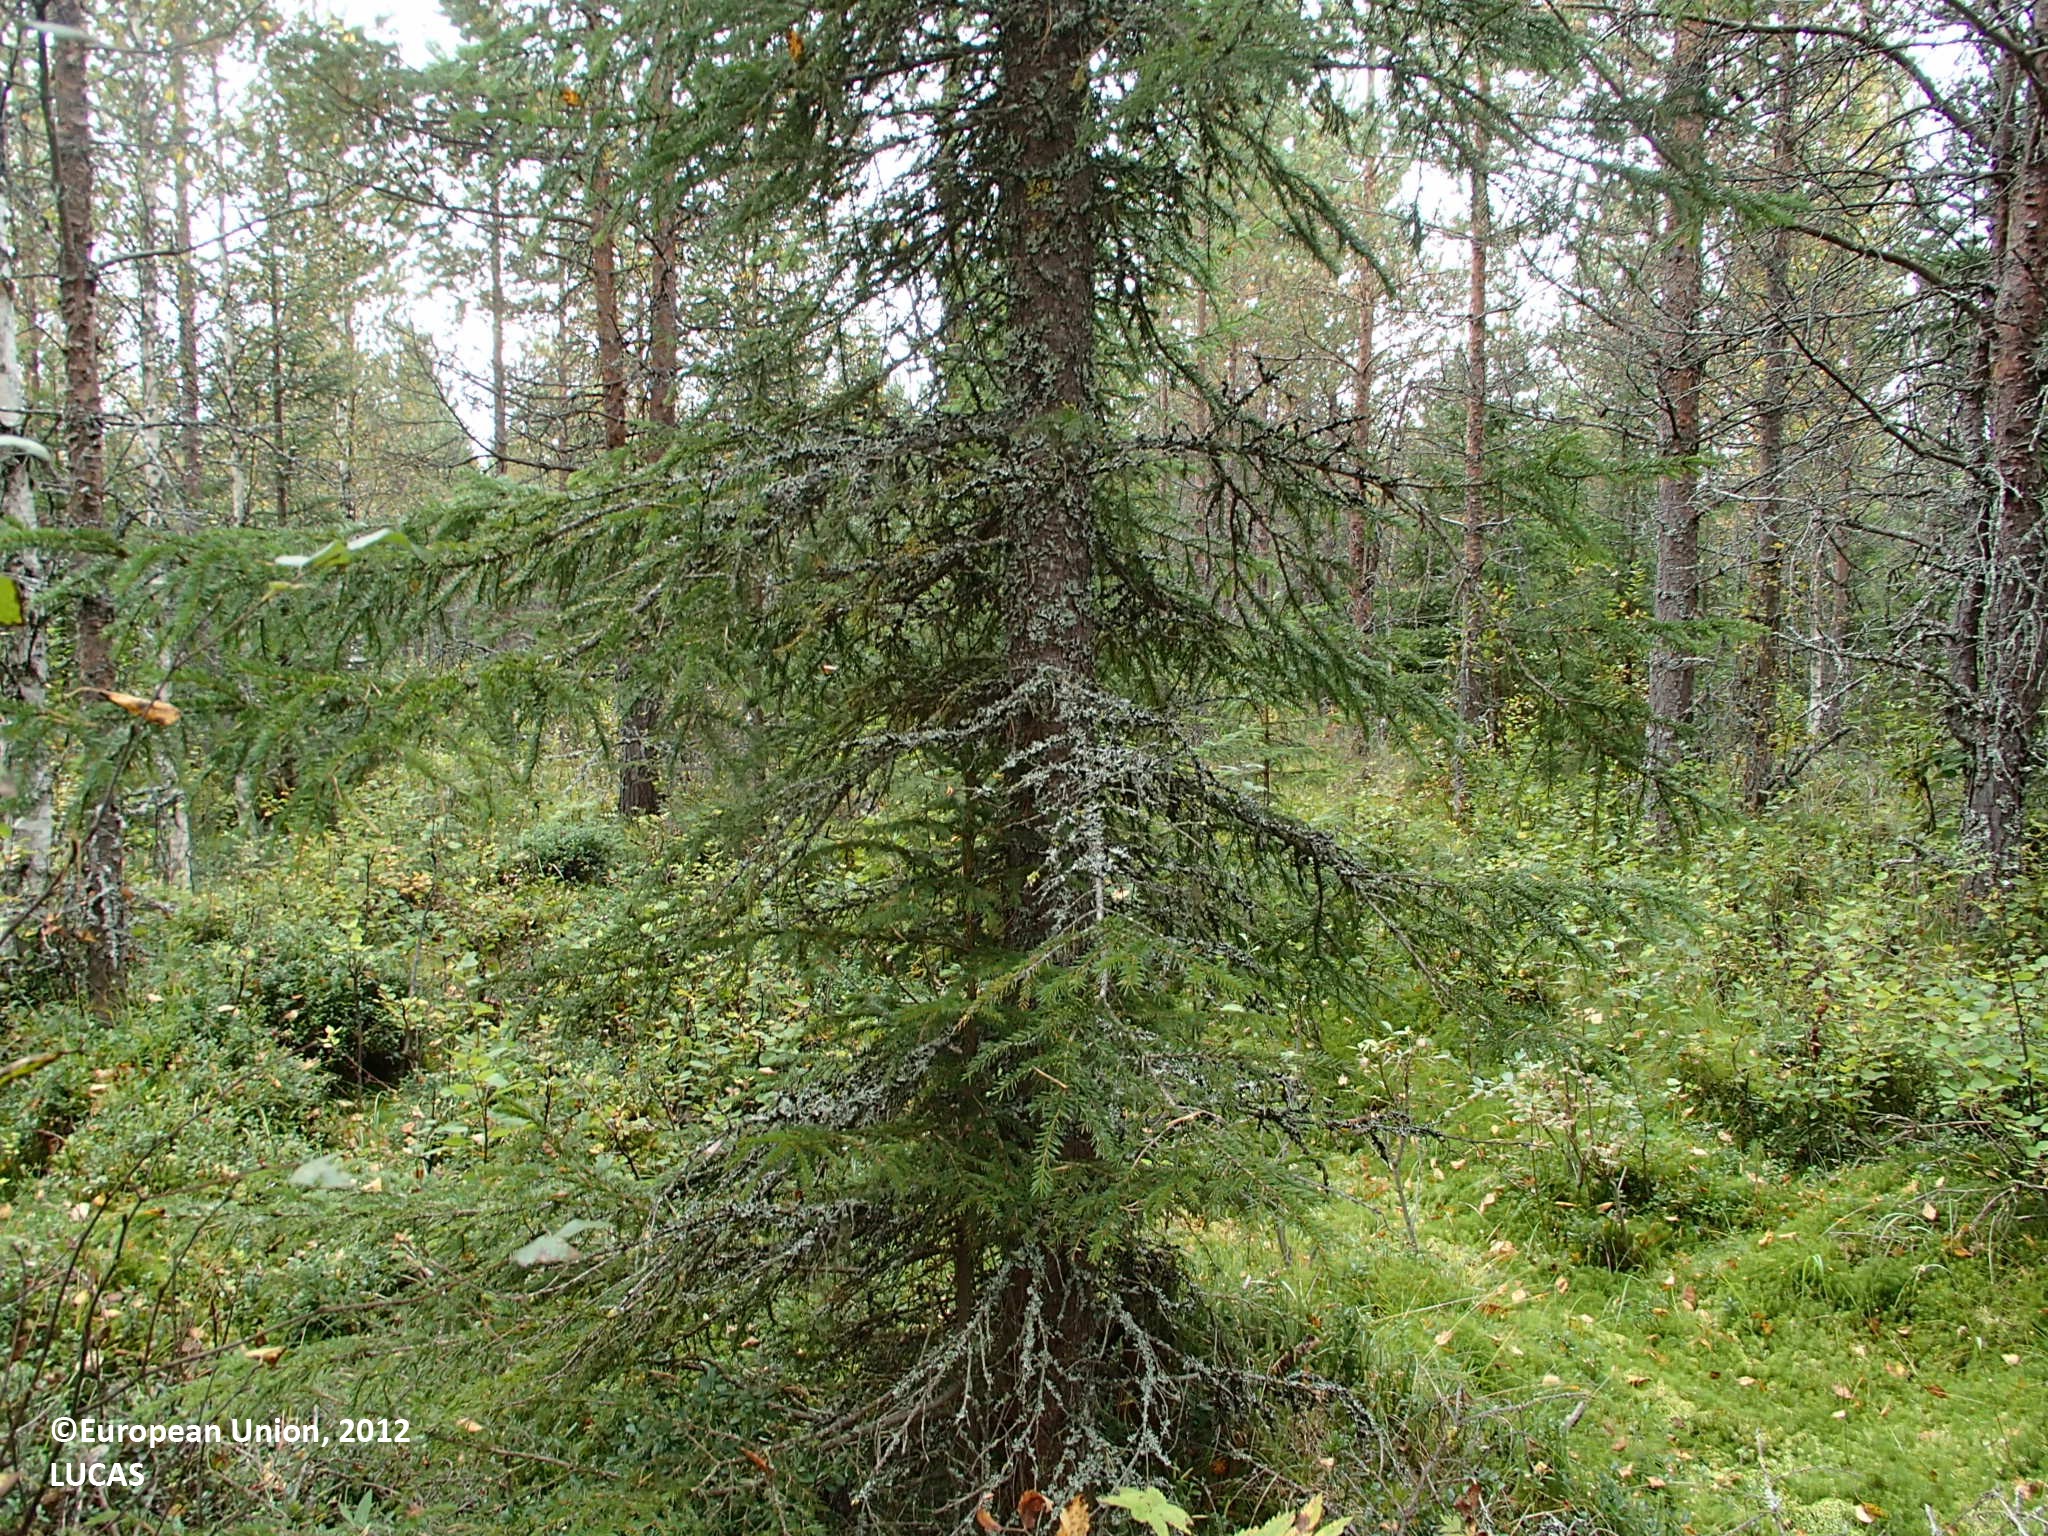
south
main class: Woodland
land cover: Other coniferous woodland
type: boreal forest
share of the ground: > 75 %
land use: Forestry
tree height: > 5 m
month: September
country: FI
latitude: 63.8523
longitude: 26.0355
